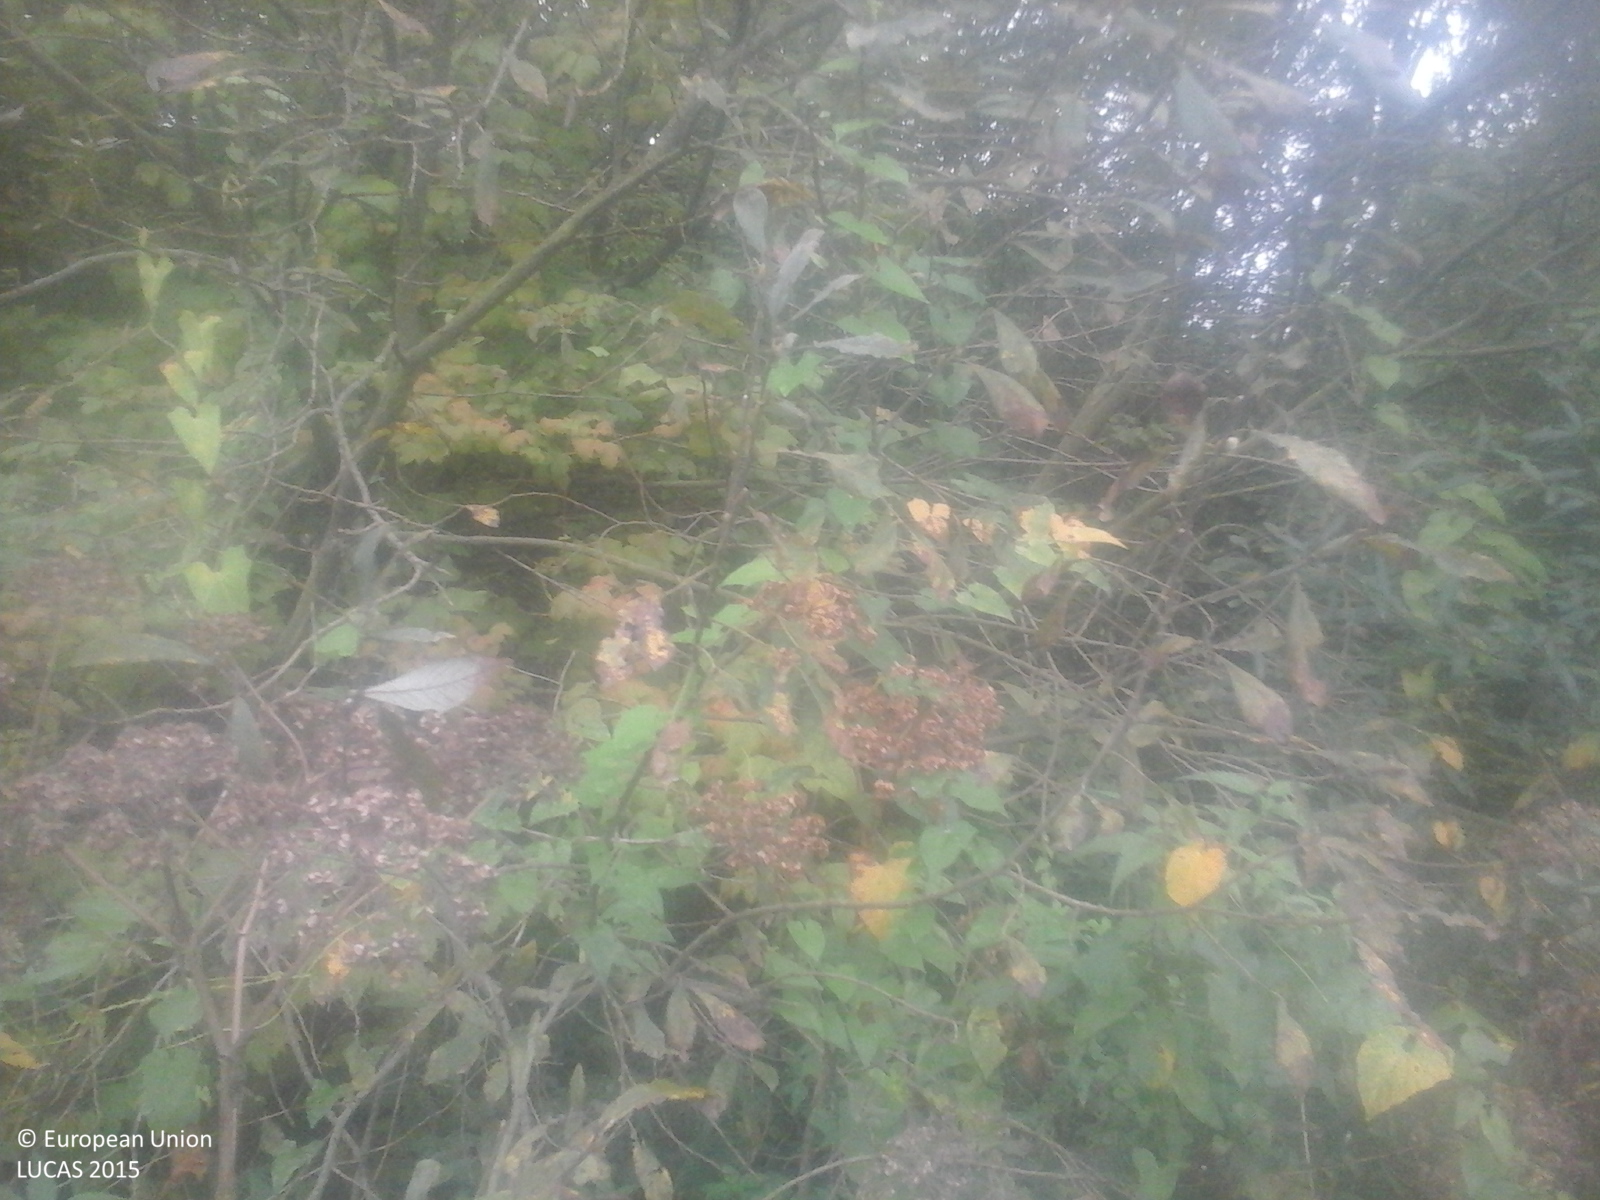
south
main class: Grassland
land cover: Spontaneously vegetated surfaces
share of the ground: > 75 %
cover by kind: herbaceous plants 100 %
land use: Fallow land
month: September
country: RO
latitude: 44.8186
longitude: 23.1901
